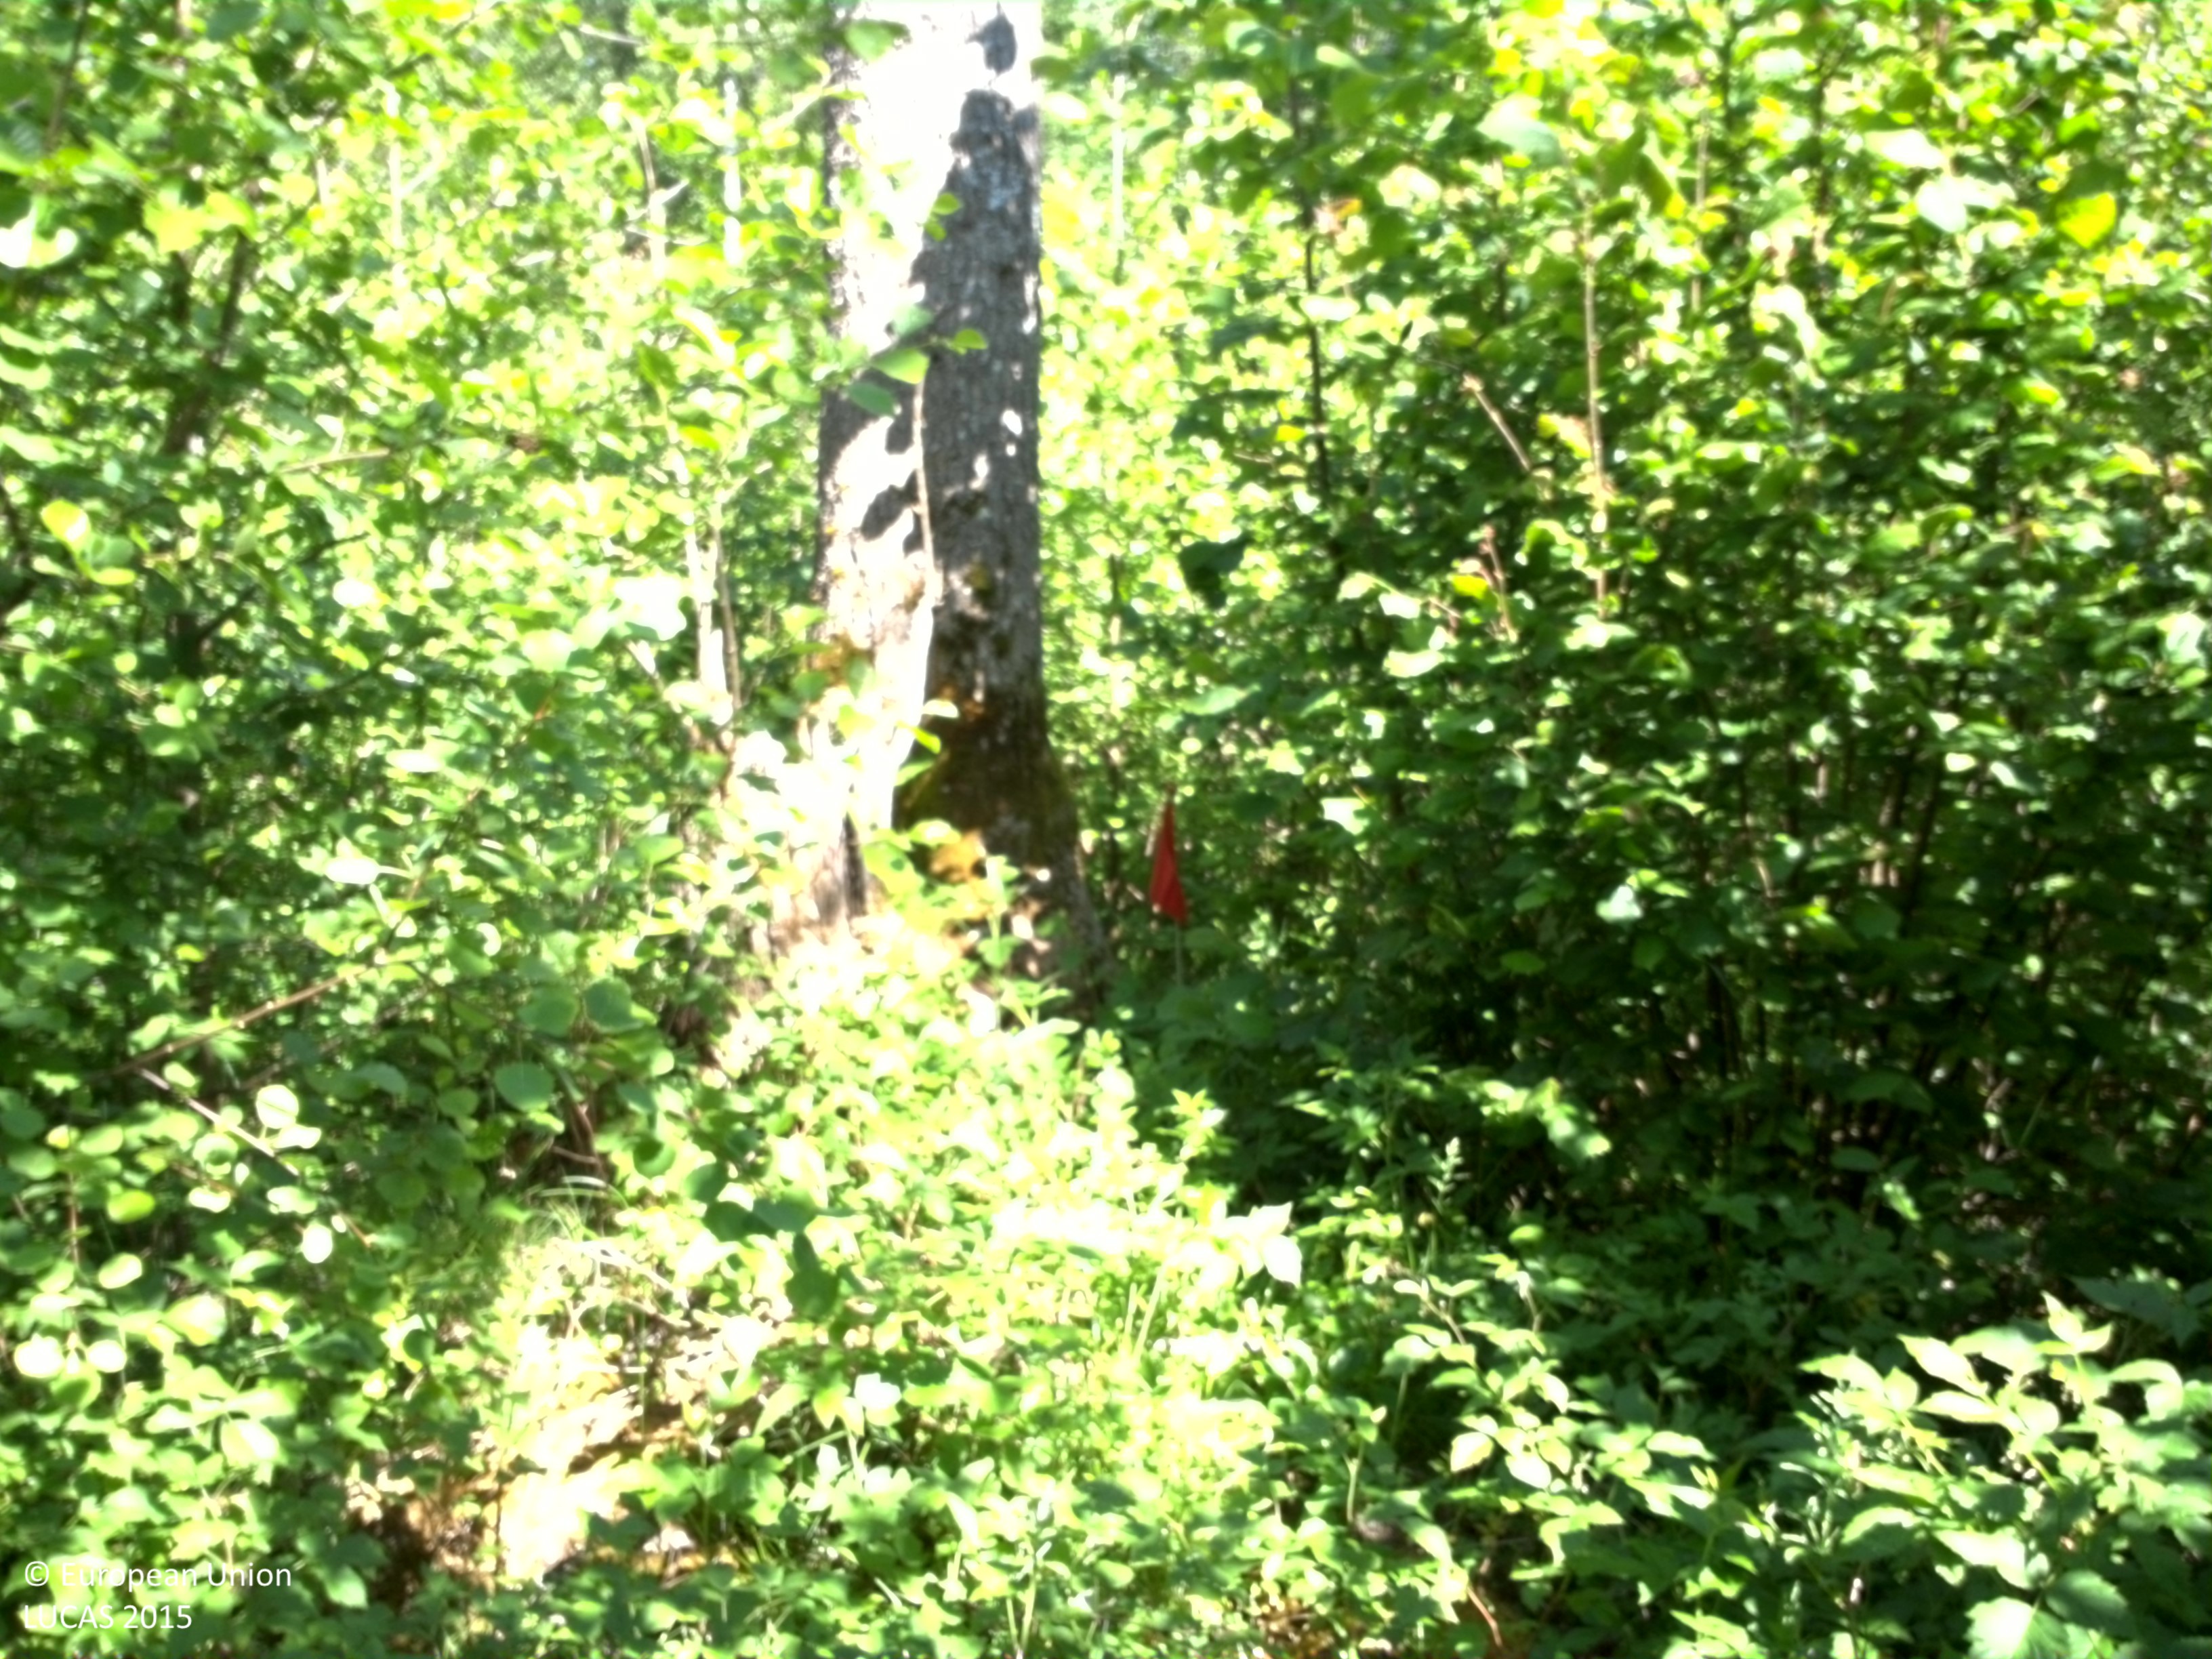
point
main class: Woodland
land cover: Broadleaved woodland
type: hemiboreal forest and nemoral coniferous forest and mixed broadleaved-coniferous forest
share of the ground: > 75 %
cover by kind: broadleaved forest trees 95 %, herbaceous plants 5 %
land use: Forestry
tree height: < 5 m
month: June
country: SE
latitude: 58.6367
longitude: 14.3170
